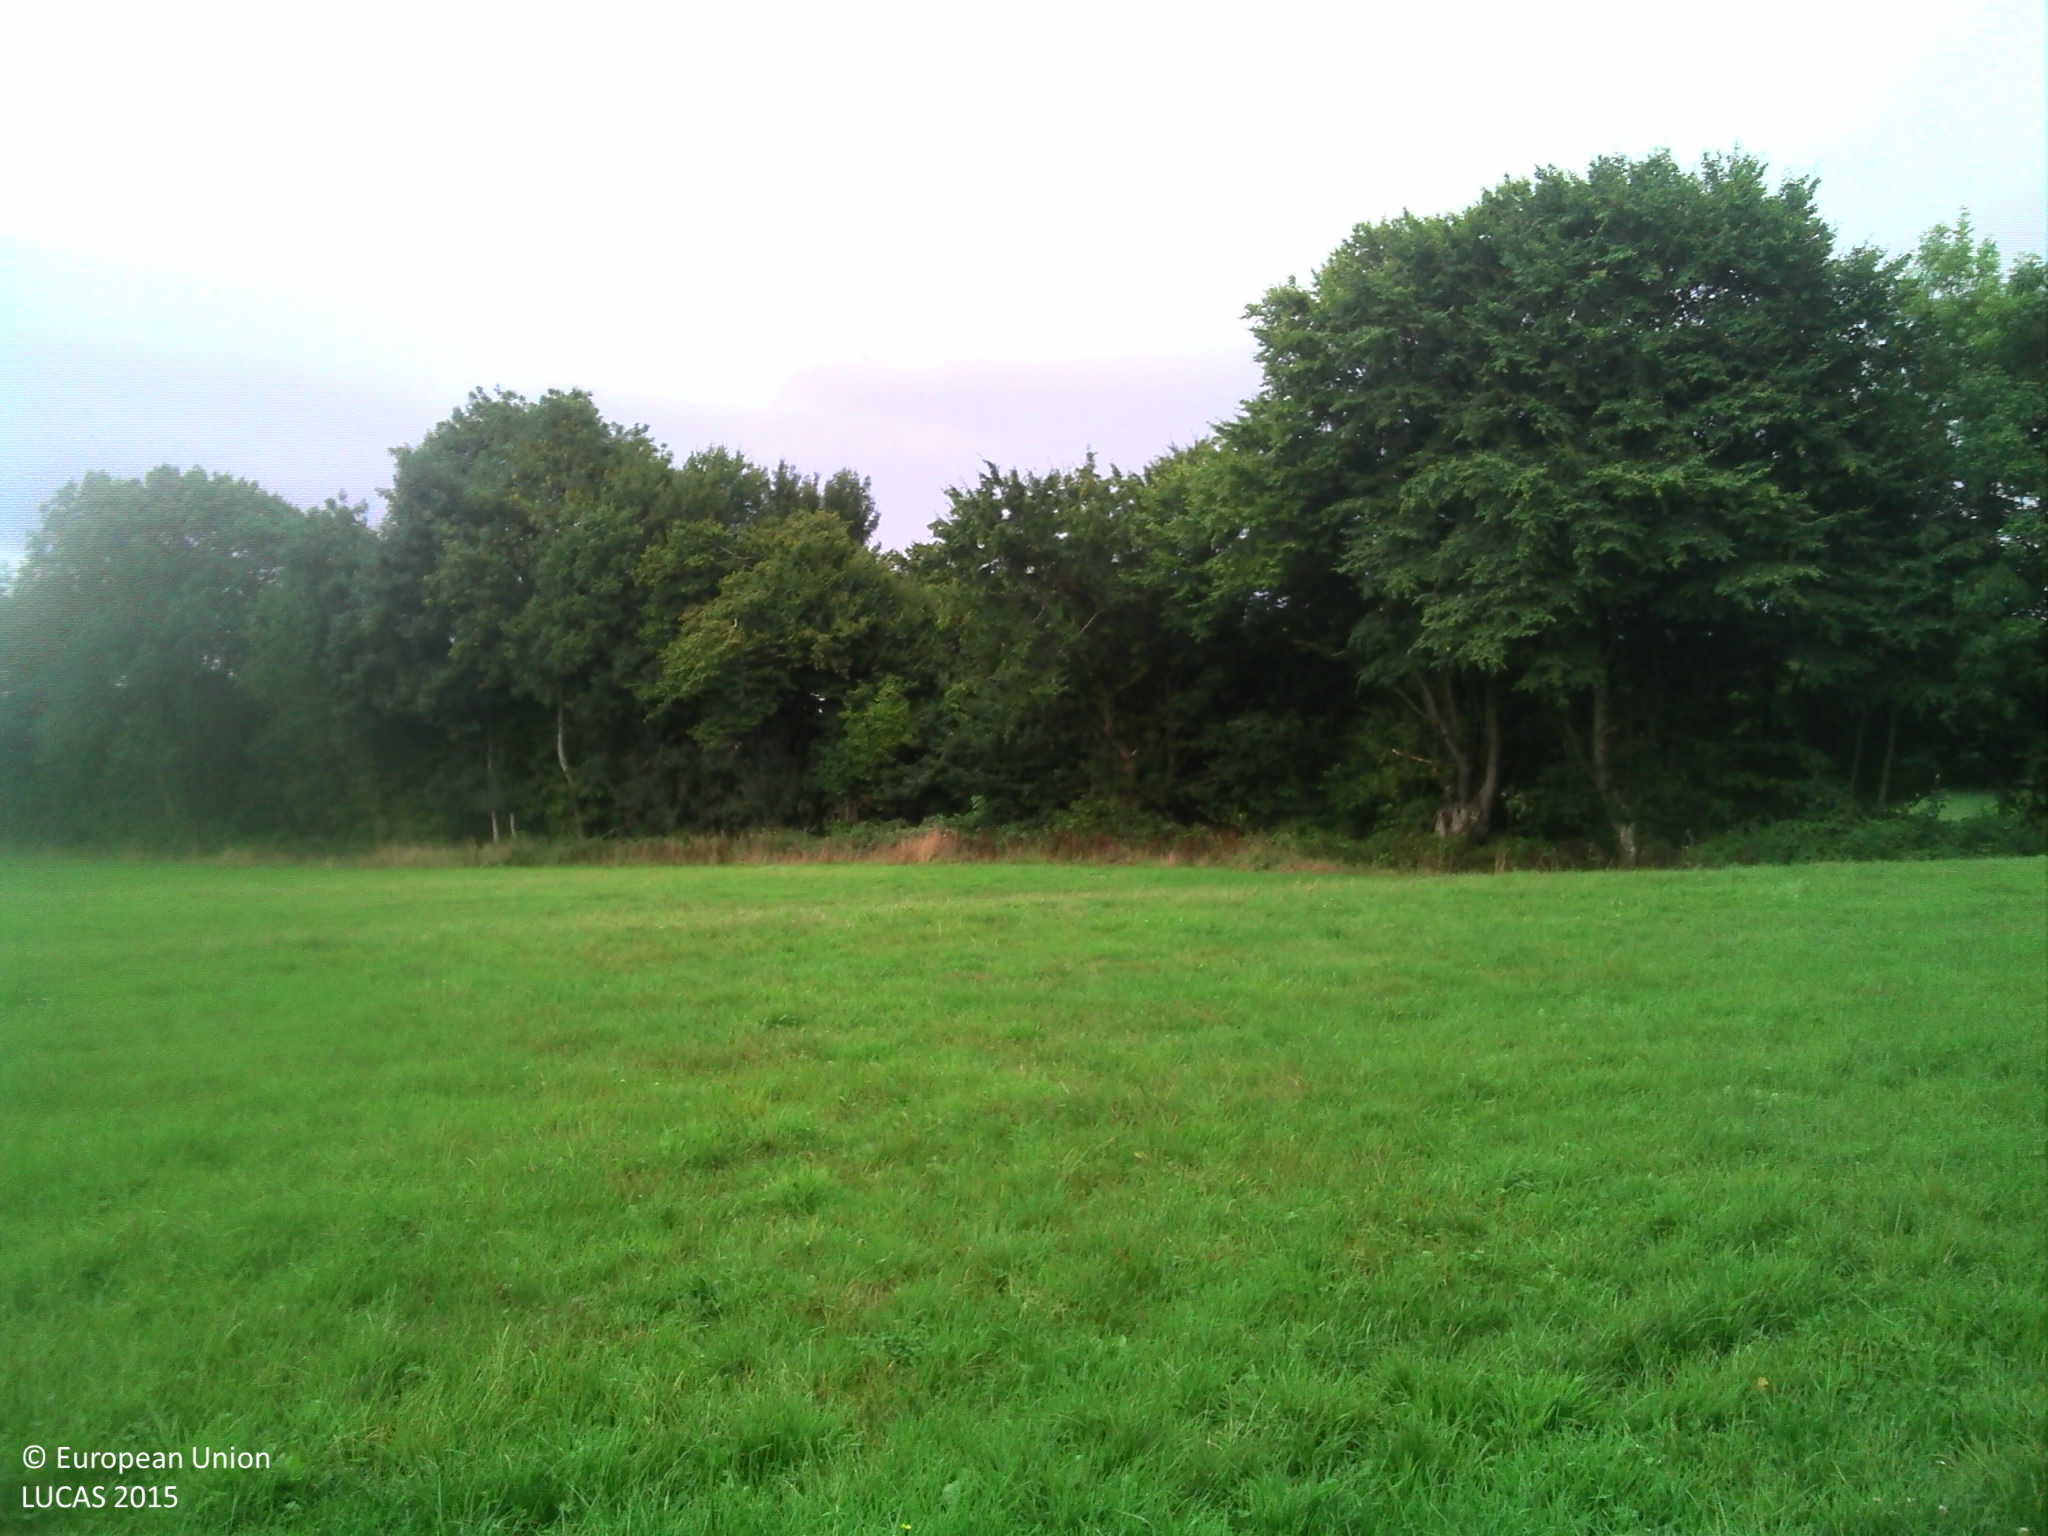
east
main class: Grassland
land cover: Grassland without tree/shrub cover
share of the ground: > 75 %
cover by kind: herbaceous plants 100 %
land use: Agriculture (excluding fallow land and kitchen gardens)
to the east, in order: Grassland without tree/shrub cover; Broadleaved woodland; Grassland without tree/shrub cover; Ditches and canals; Grassland without tree/shrub cover; Spontaneously vegetated surfaces; Broadleaved woodland; Other bare soil
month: August
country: FR
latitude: 48.4153
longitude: 0.5586
